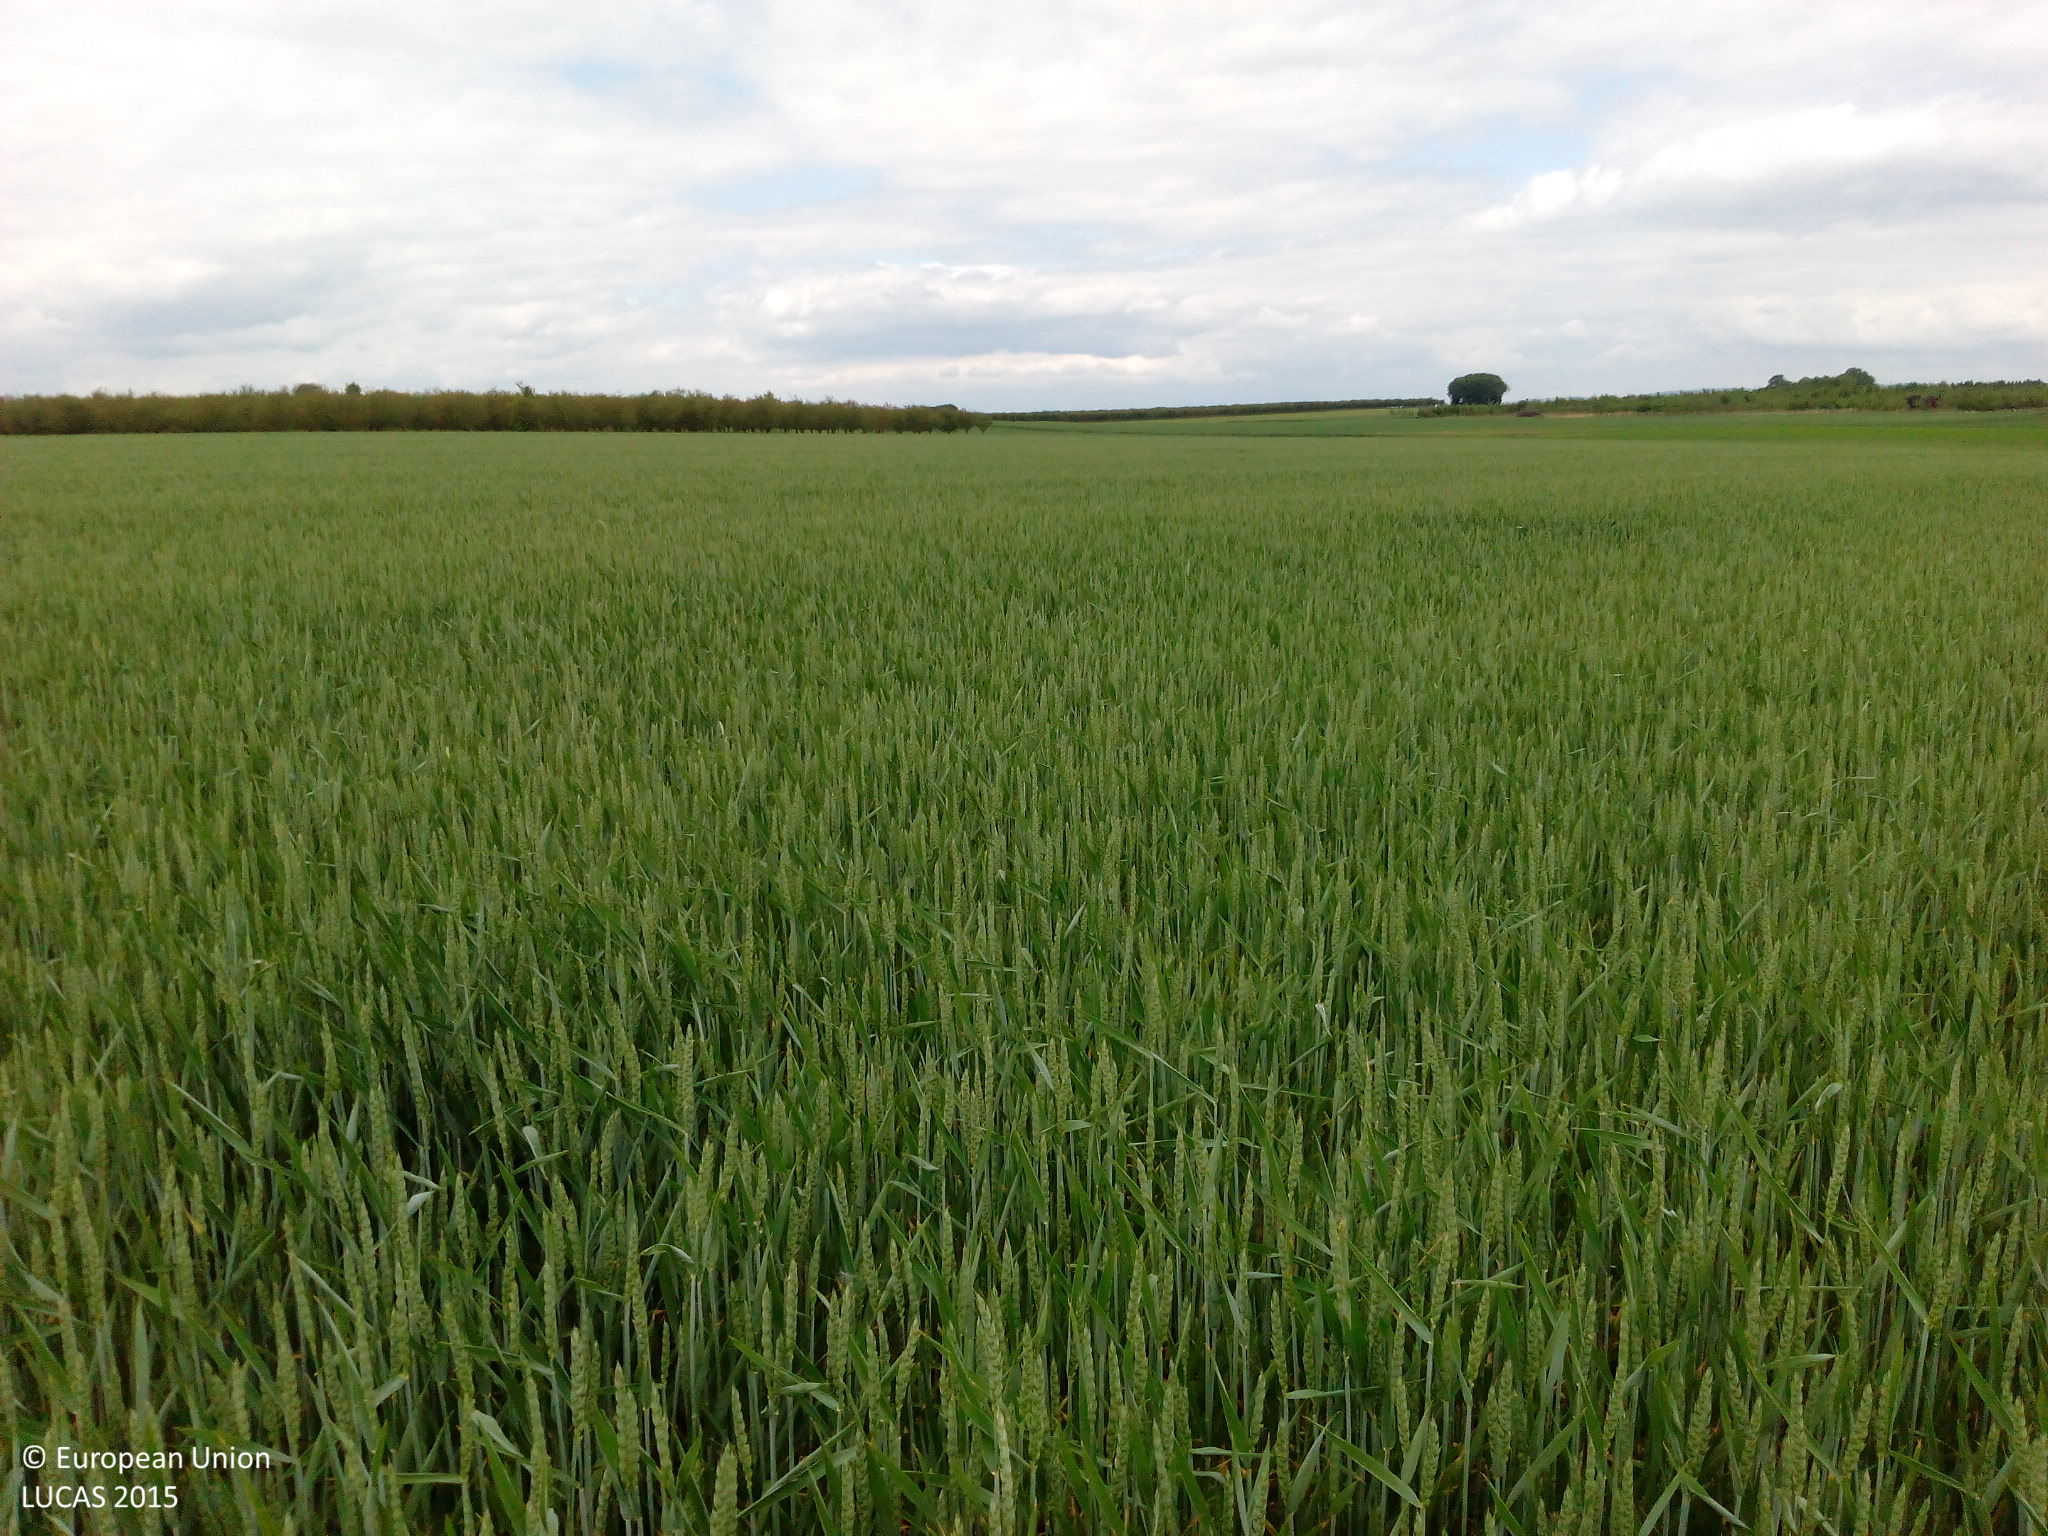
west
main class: Cropland
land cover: Common wheat
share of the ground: > 75 %
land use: Agriculture (excluding fallow land and kitchen gardens)
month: May
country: DE
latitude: 49.9155
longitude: 8.0368
